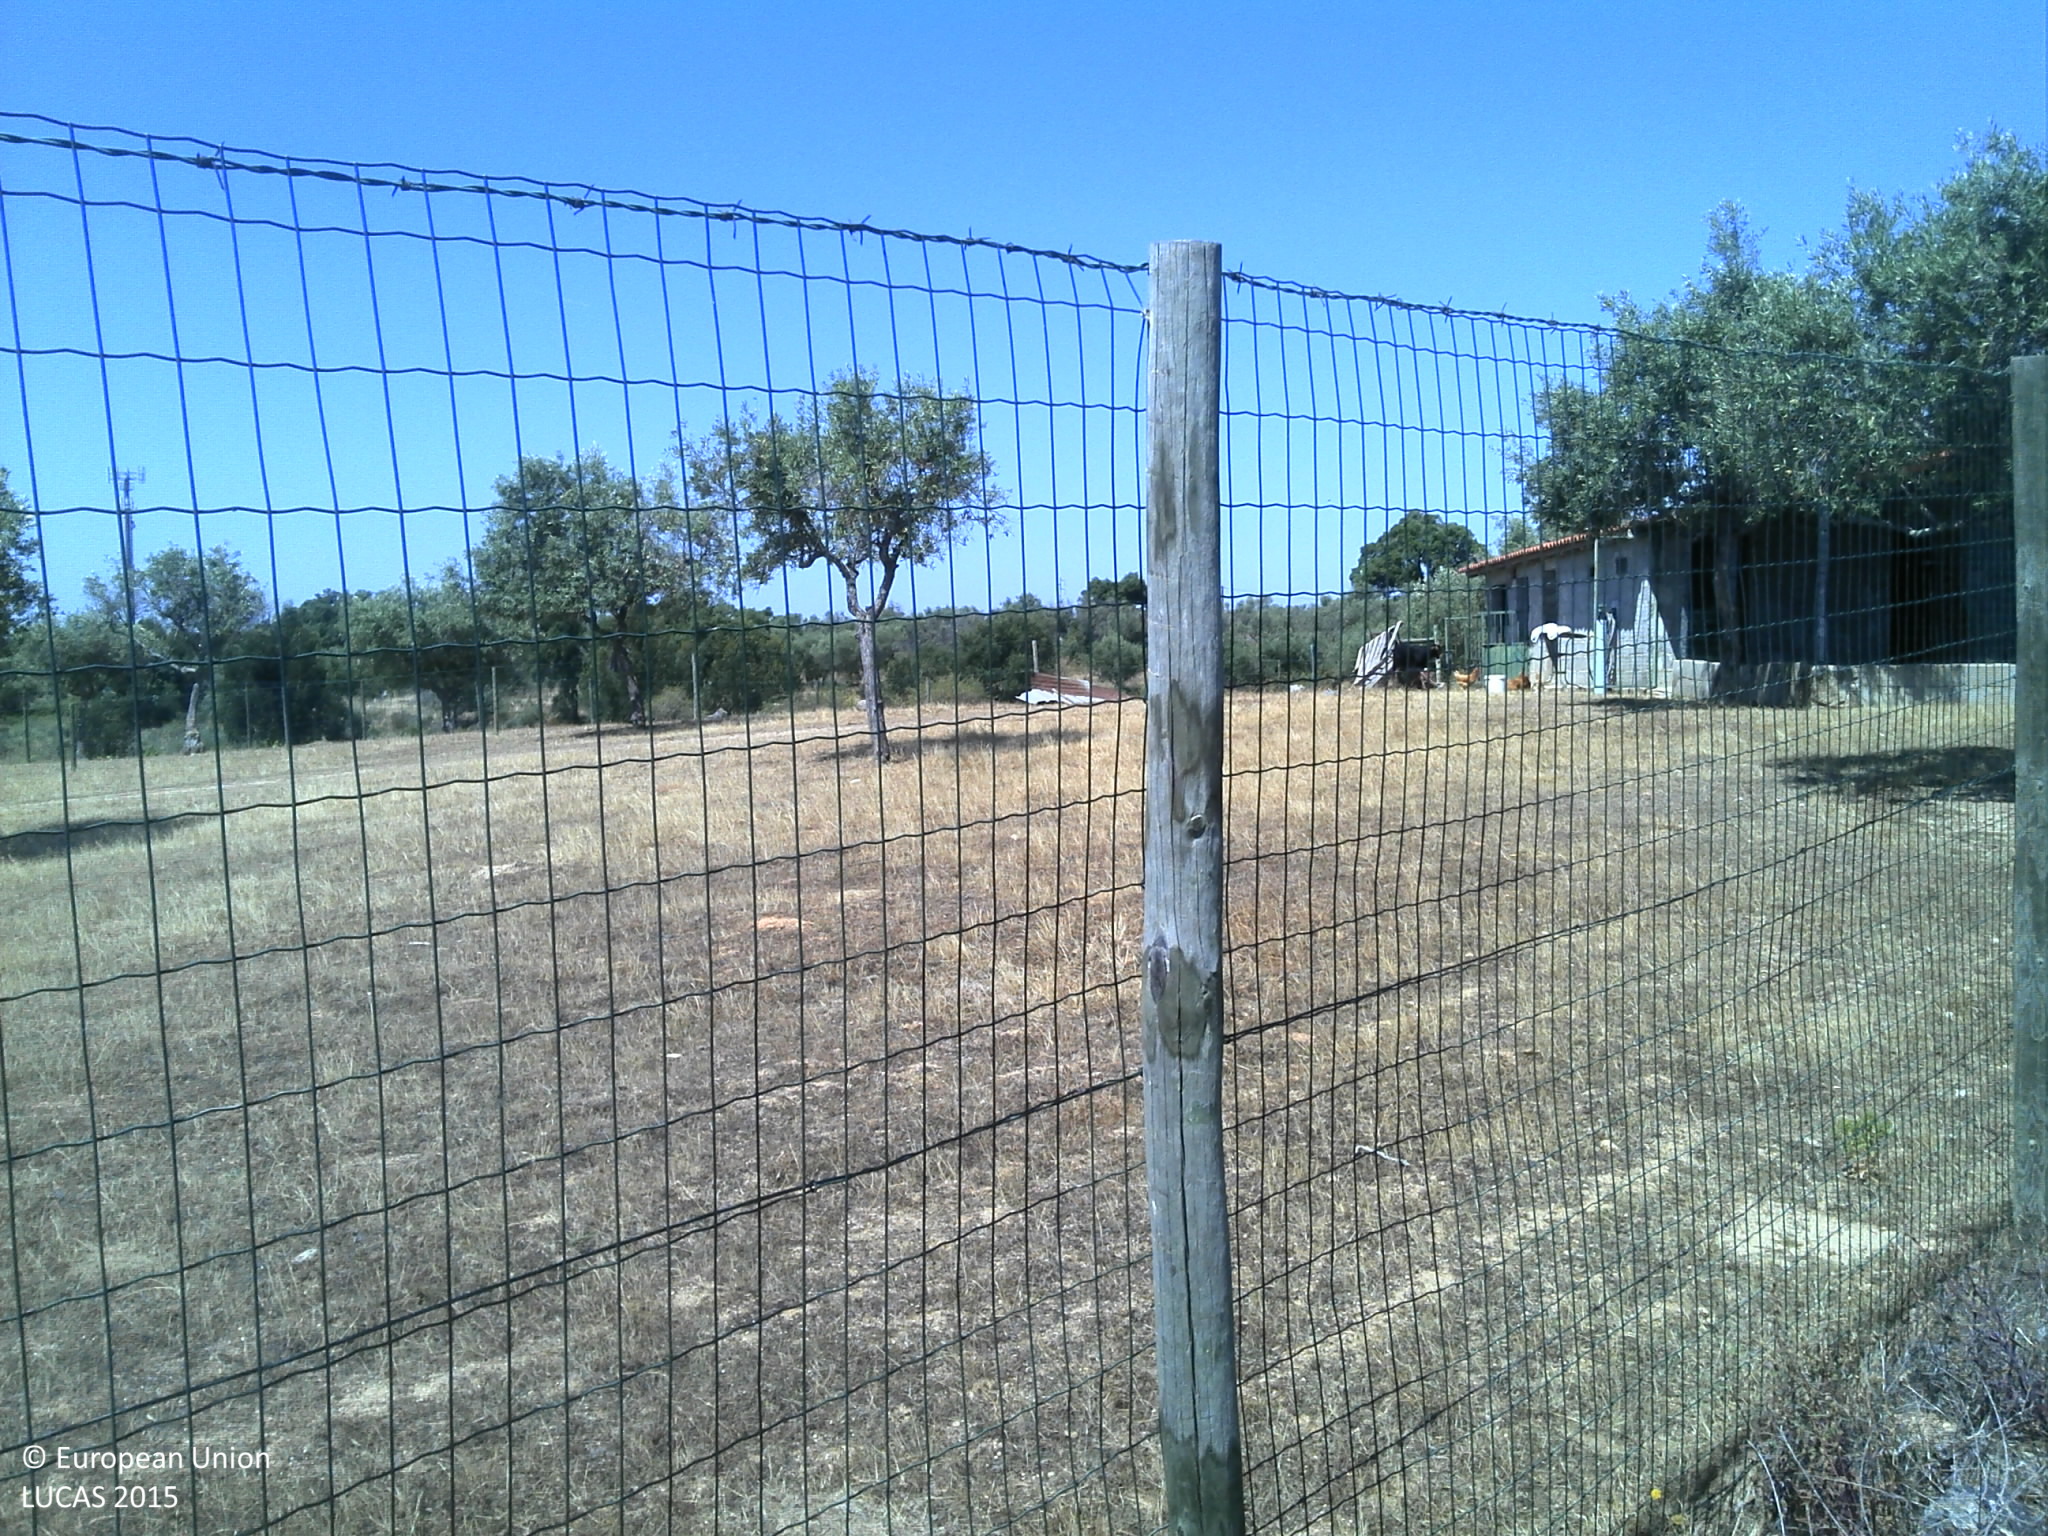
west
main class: Cropland
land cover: Olive groves
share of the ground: 25 - 50 %
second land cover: Grassland without tree/shrub cover
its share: 50 - 75 %
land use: Agriculture (excluding fallow land and kitchen gardens)
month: June
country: PT
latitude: 40.0252
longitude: -7.3113
